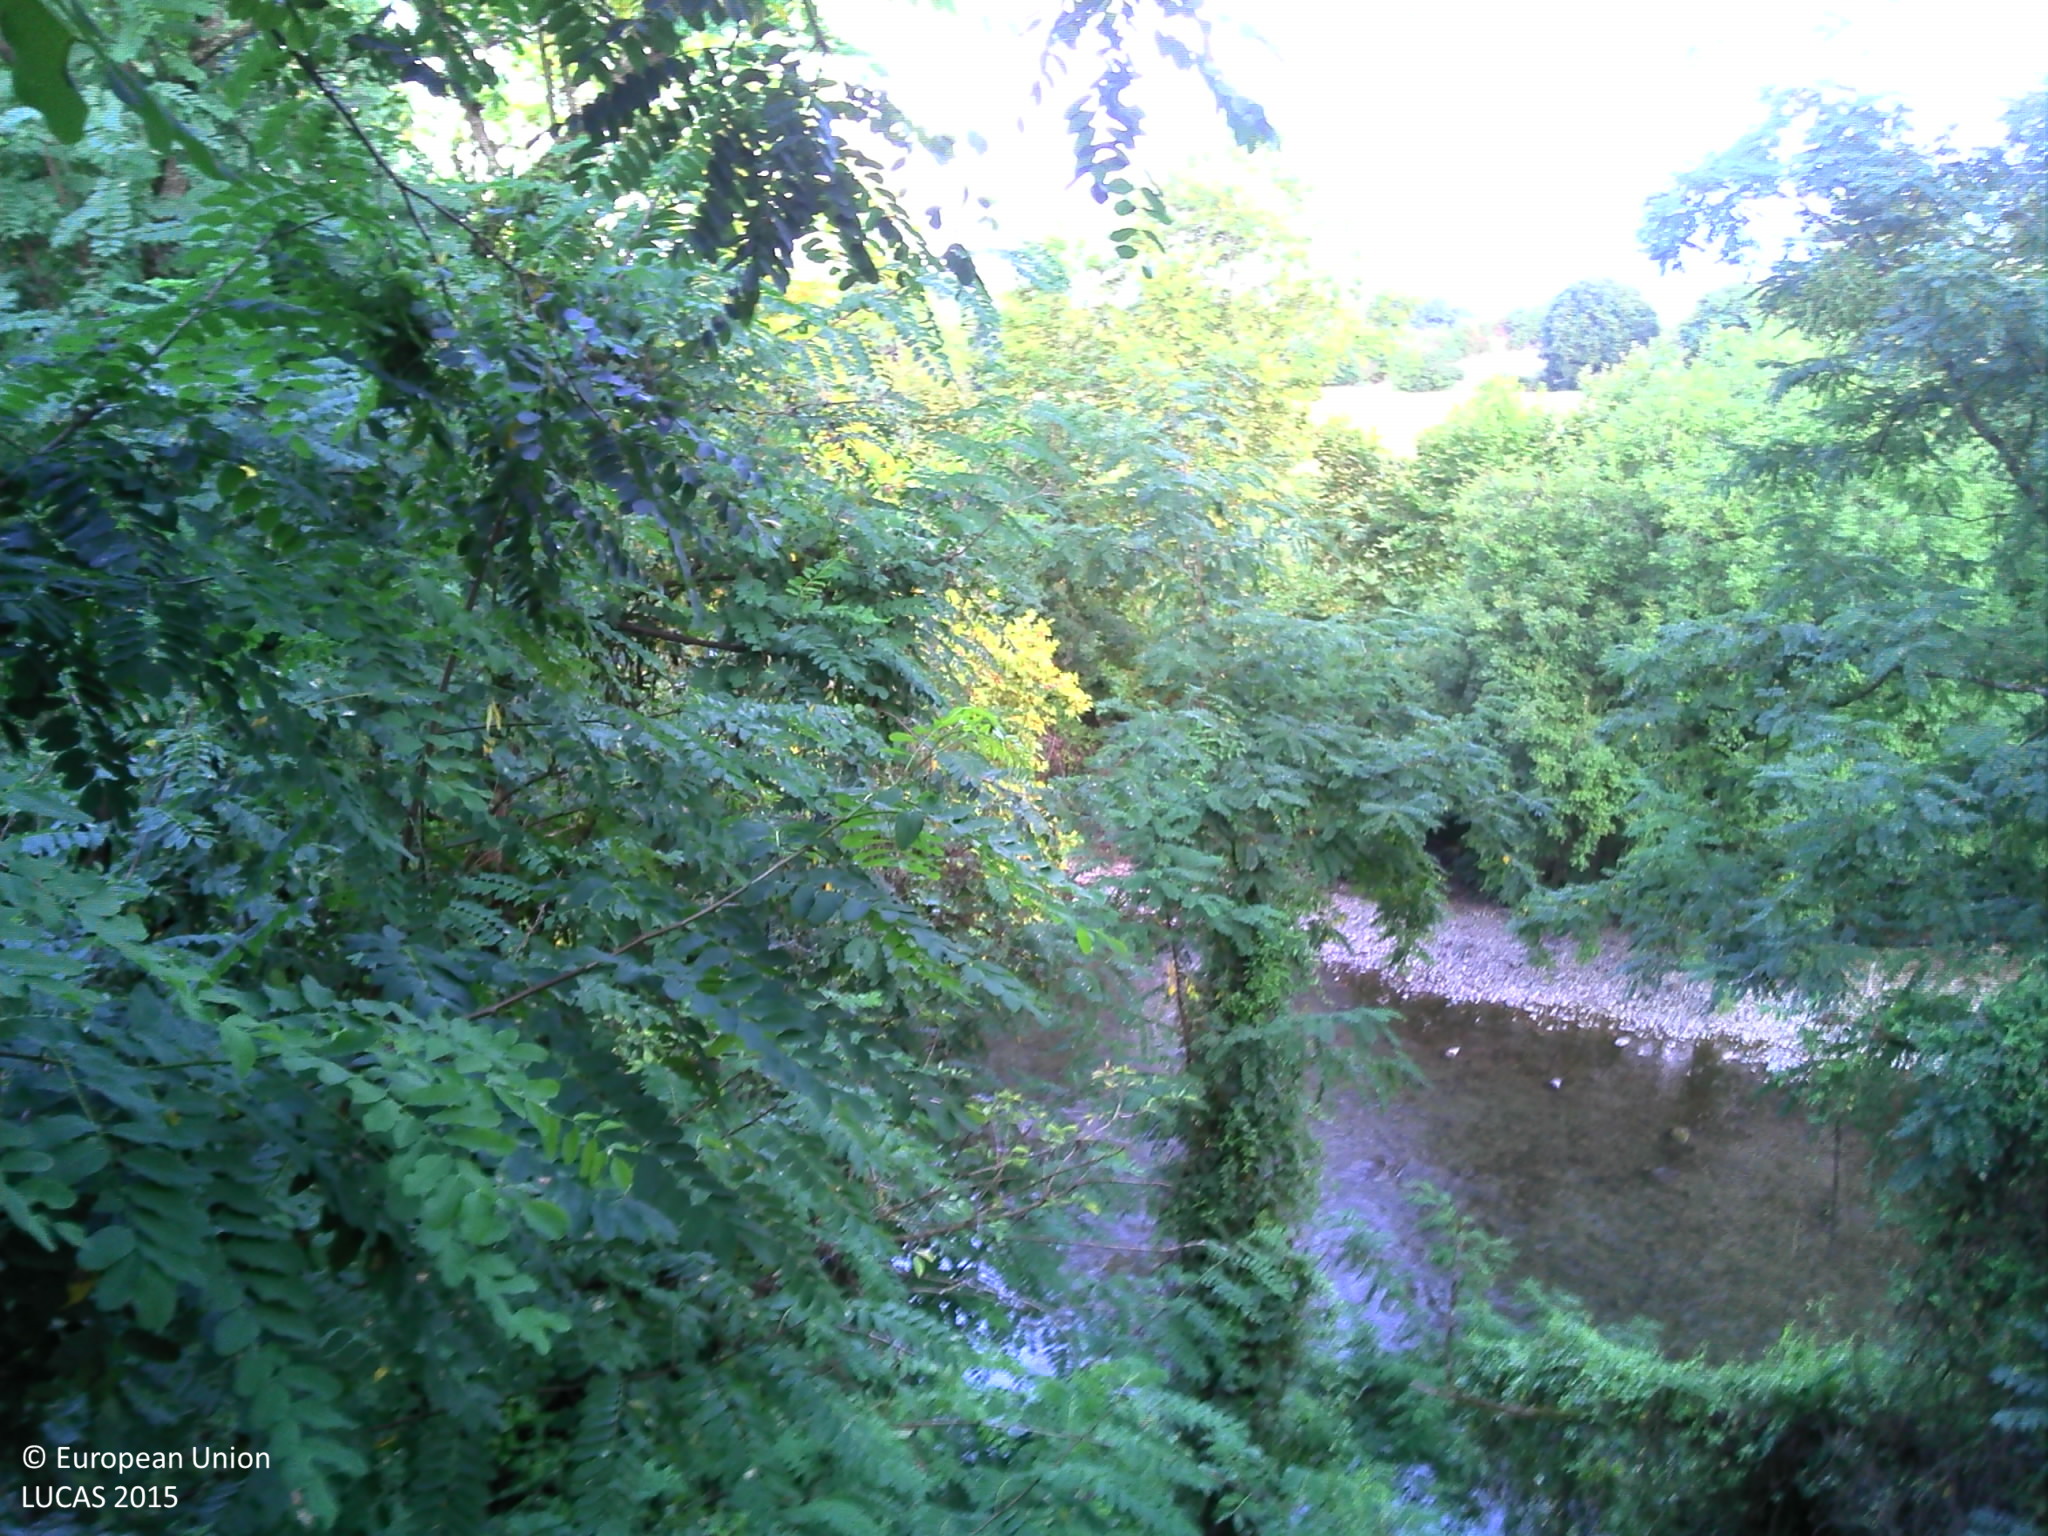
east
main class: Woodland
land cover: Broadleaved woodland
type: floodplain forest
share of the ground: 50 - 75 %
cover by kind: broadleaved forest trees 70 %, shrubs 30 %
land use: Semi-natural and natural areas not in use
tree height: > 5 m
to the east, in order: Broadleaved woodland; Inland fresh running water; Rocks and stones; Broadleaved woodland; Grass margins; Maize; Grass margins; Maize
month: September
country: FR
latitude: 43.3708
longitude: -0.9340
